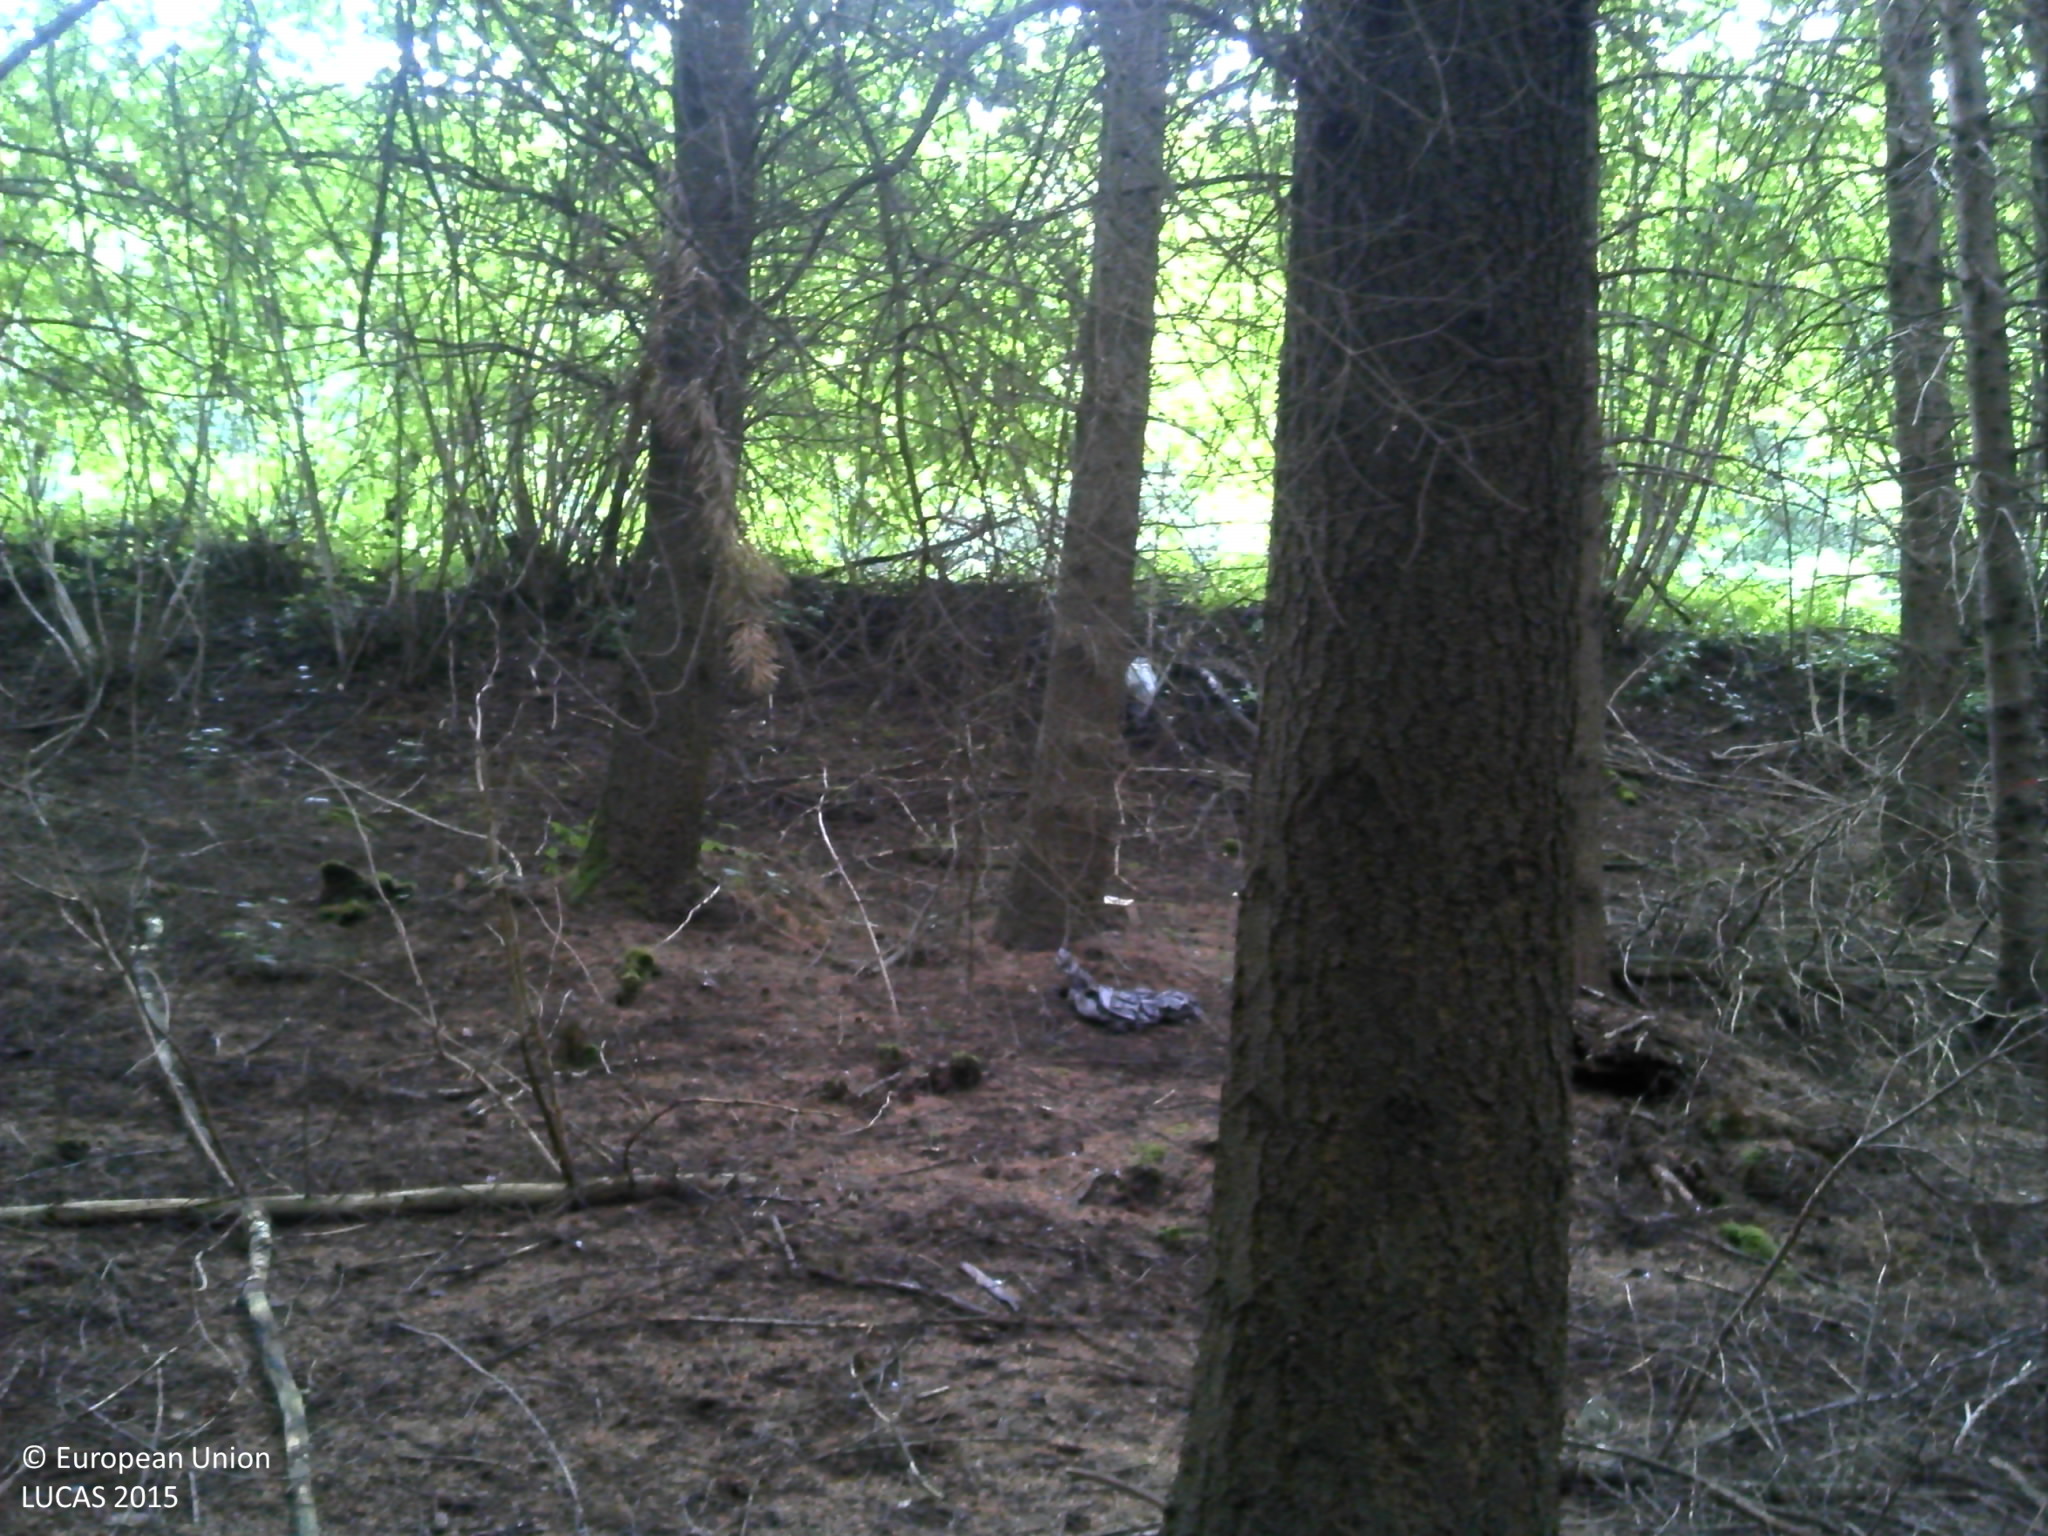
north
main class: Woodland
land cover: Spruce dominated coniferous woodland
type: alpine coniferous forest
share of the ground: > 75 %
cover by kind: coniferous forest trees 80 %, consolidated bare surface 15 %, lichens and mosses 5 %
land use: Forestry
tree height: > 5 m
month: July
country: FR
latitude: 49.7960
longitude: 4.8151
